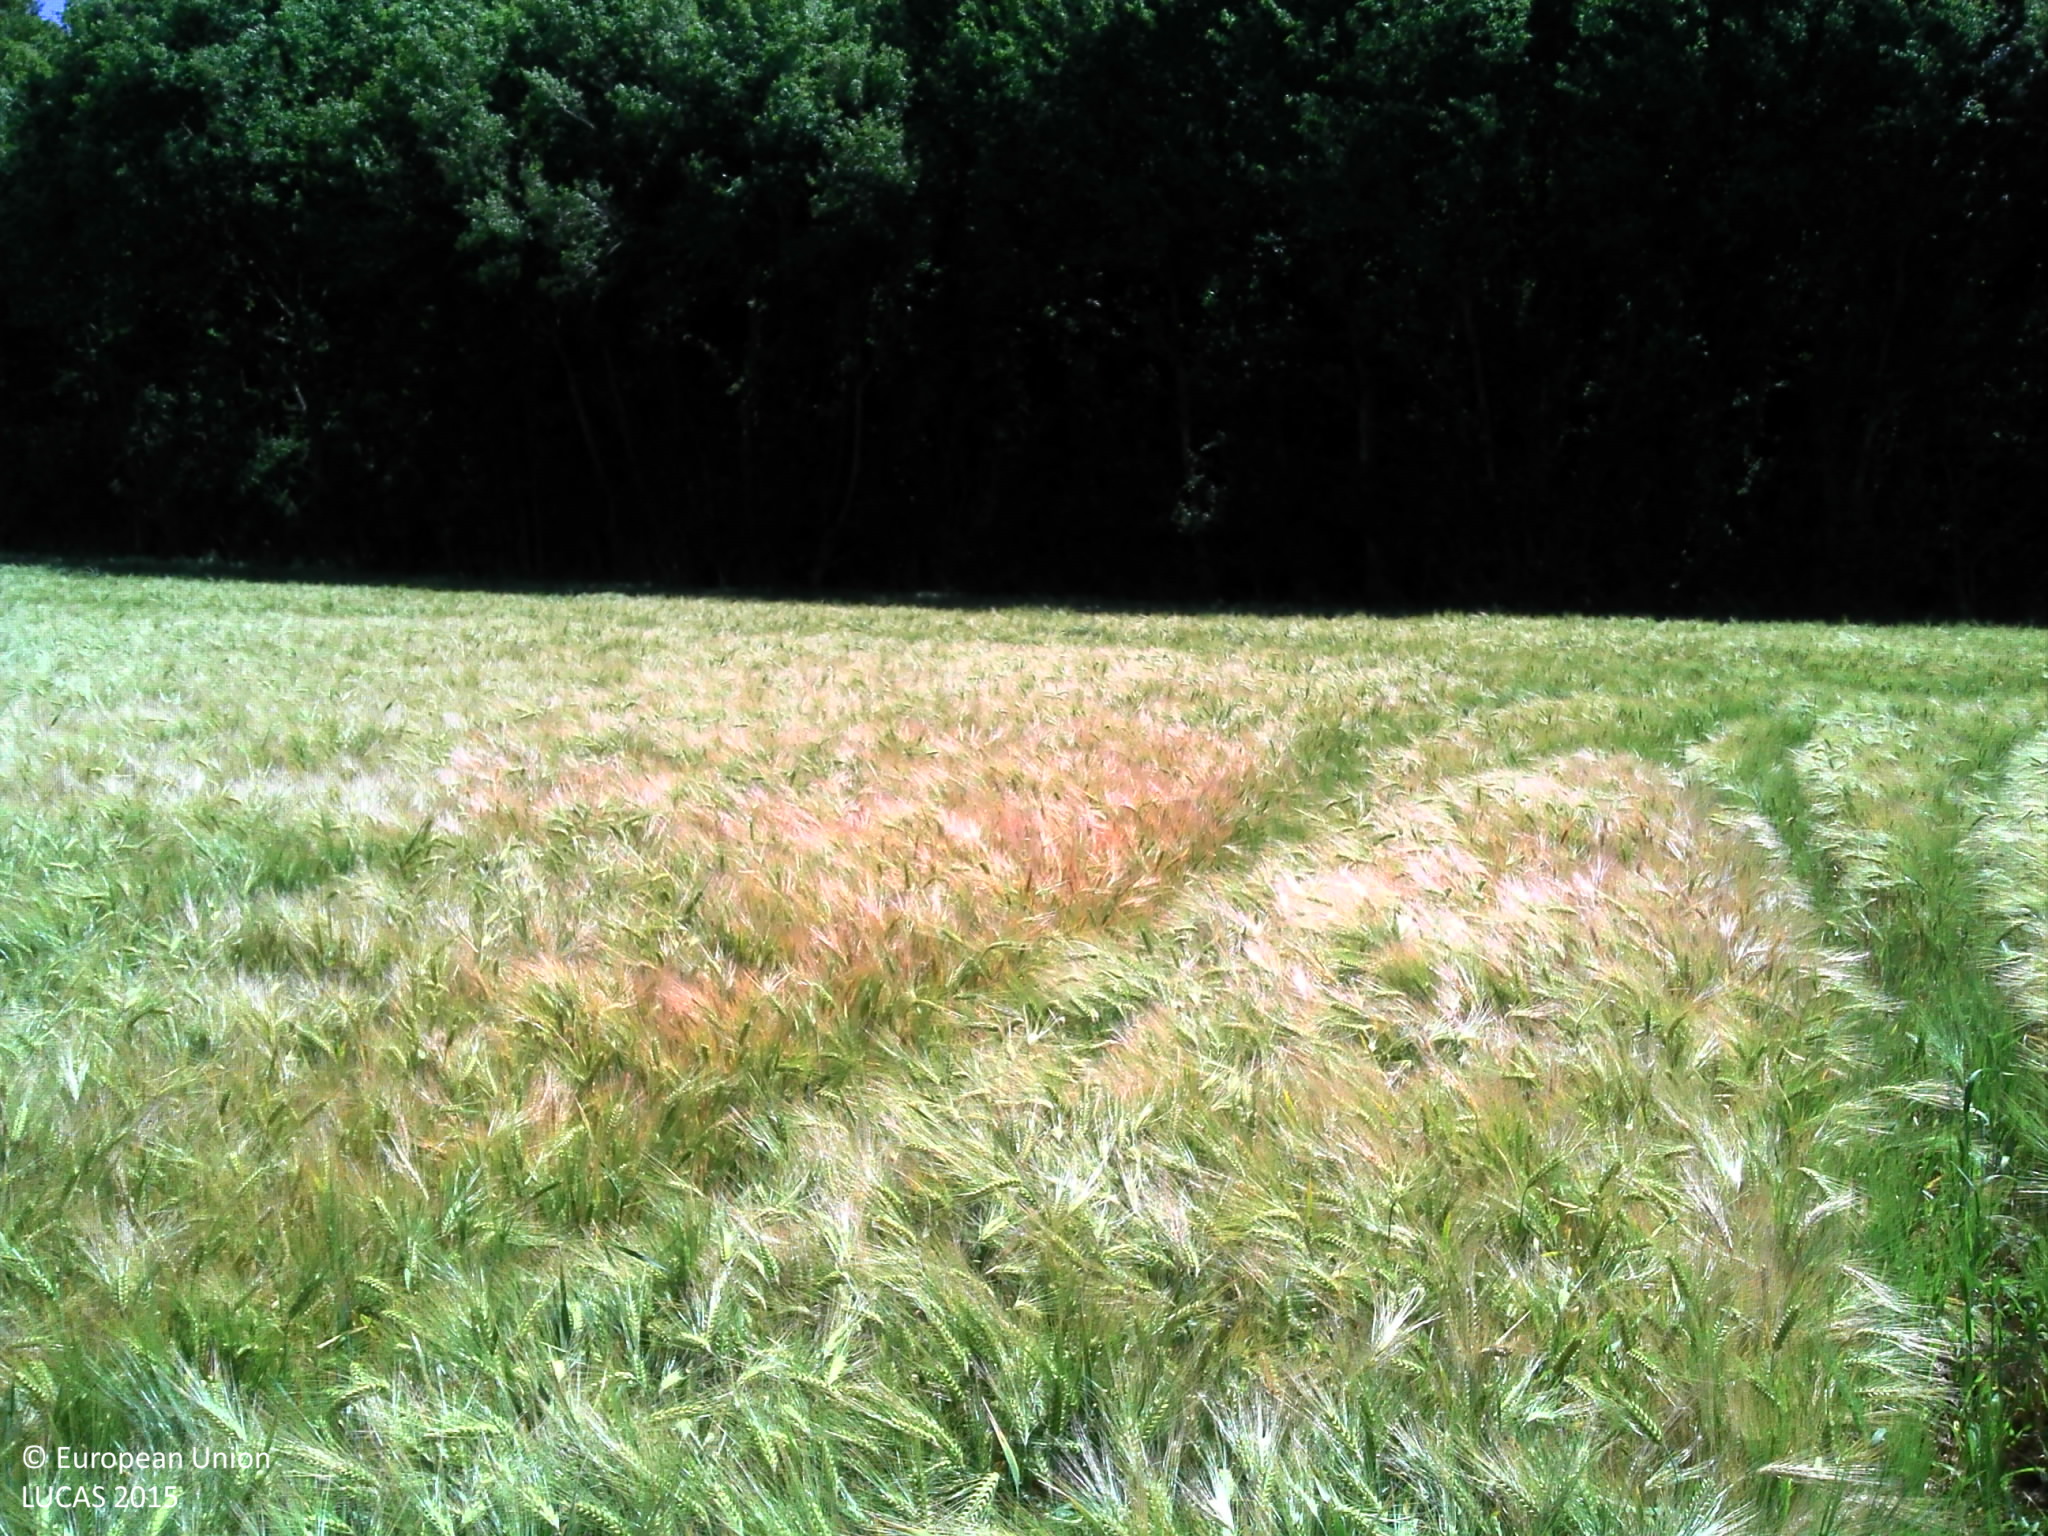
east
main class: Cropland
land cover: Barley
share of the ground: > 75 %
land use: Agriculture (excluding fallow land and kitchen gardens)
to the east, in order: Barley; Broadleaved woodland; Ditches and canals; Tracks; Ditches and canals; Broadleaved woodland
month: June
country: FR
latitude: 47.0567
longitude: 2.9256
